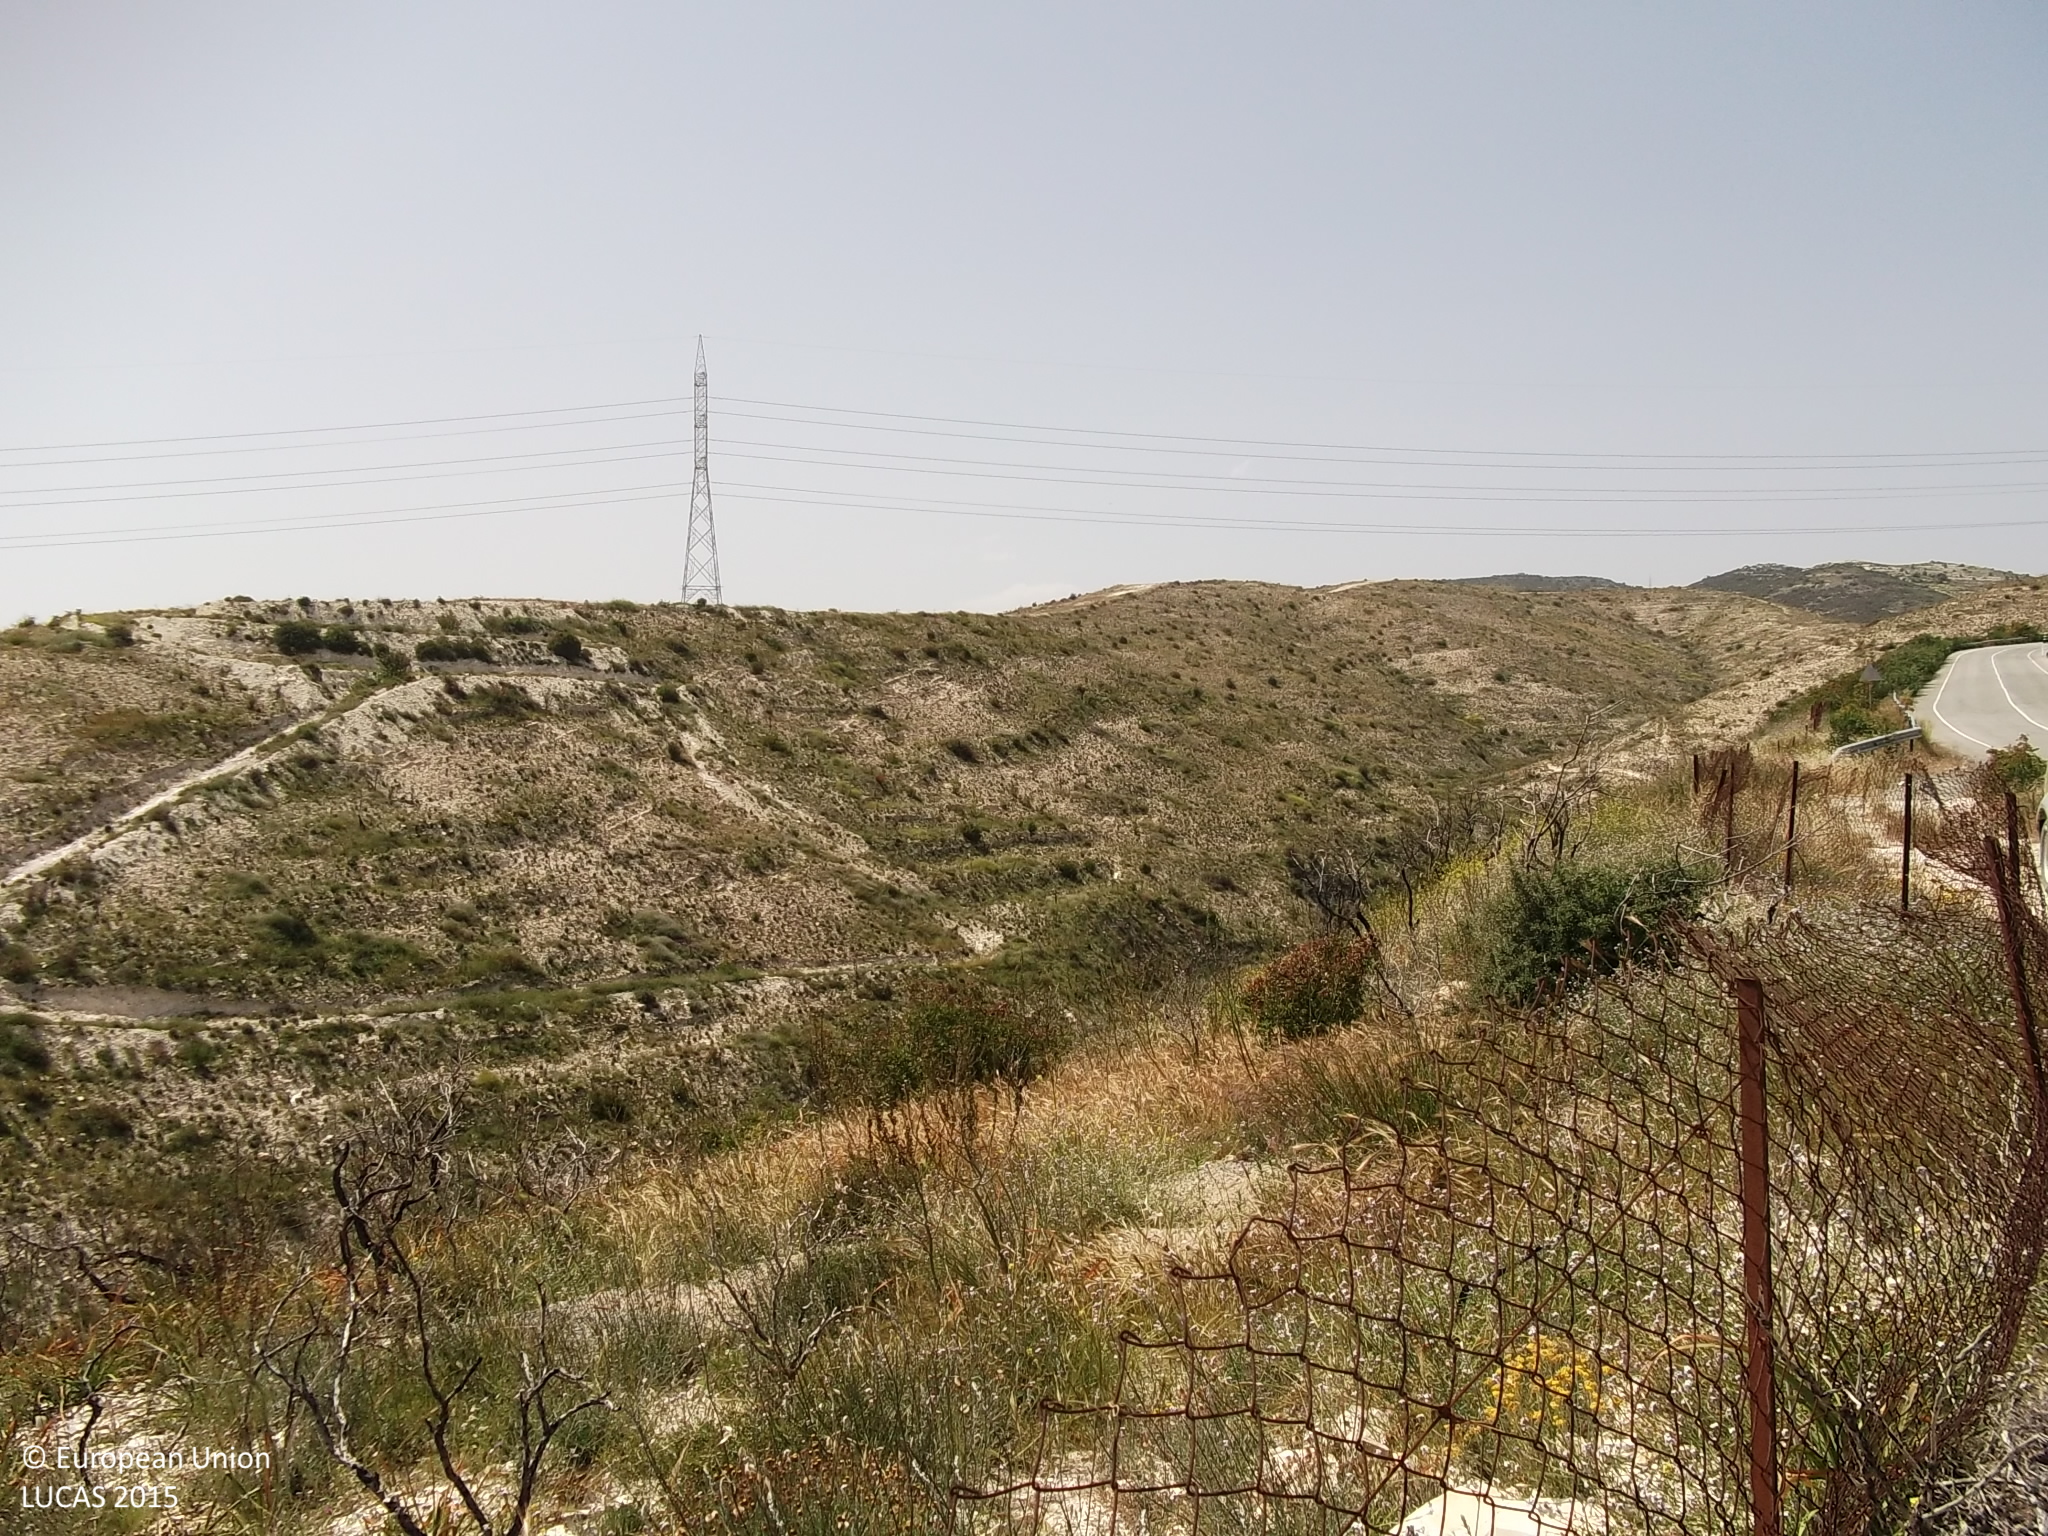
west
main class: Grassland
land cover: Spontaneously vegetated surfaces
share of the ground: 50 - 75 %
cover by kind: herbaceous plants 60 %, unconsolidated bare surface 40 %
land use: Semi-natural and natural areas not in use
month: April
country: CY
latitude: 34.8398
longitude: 33.3320
